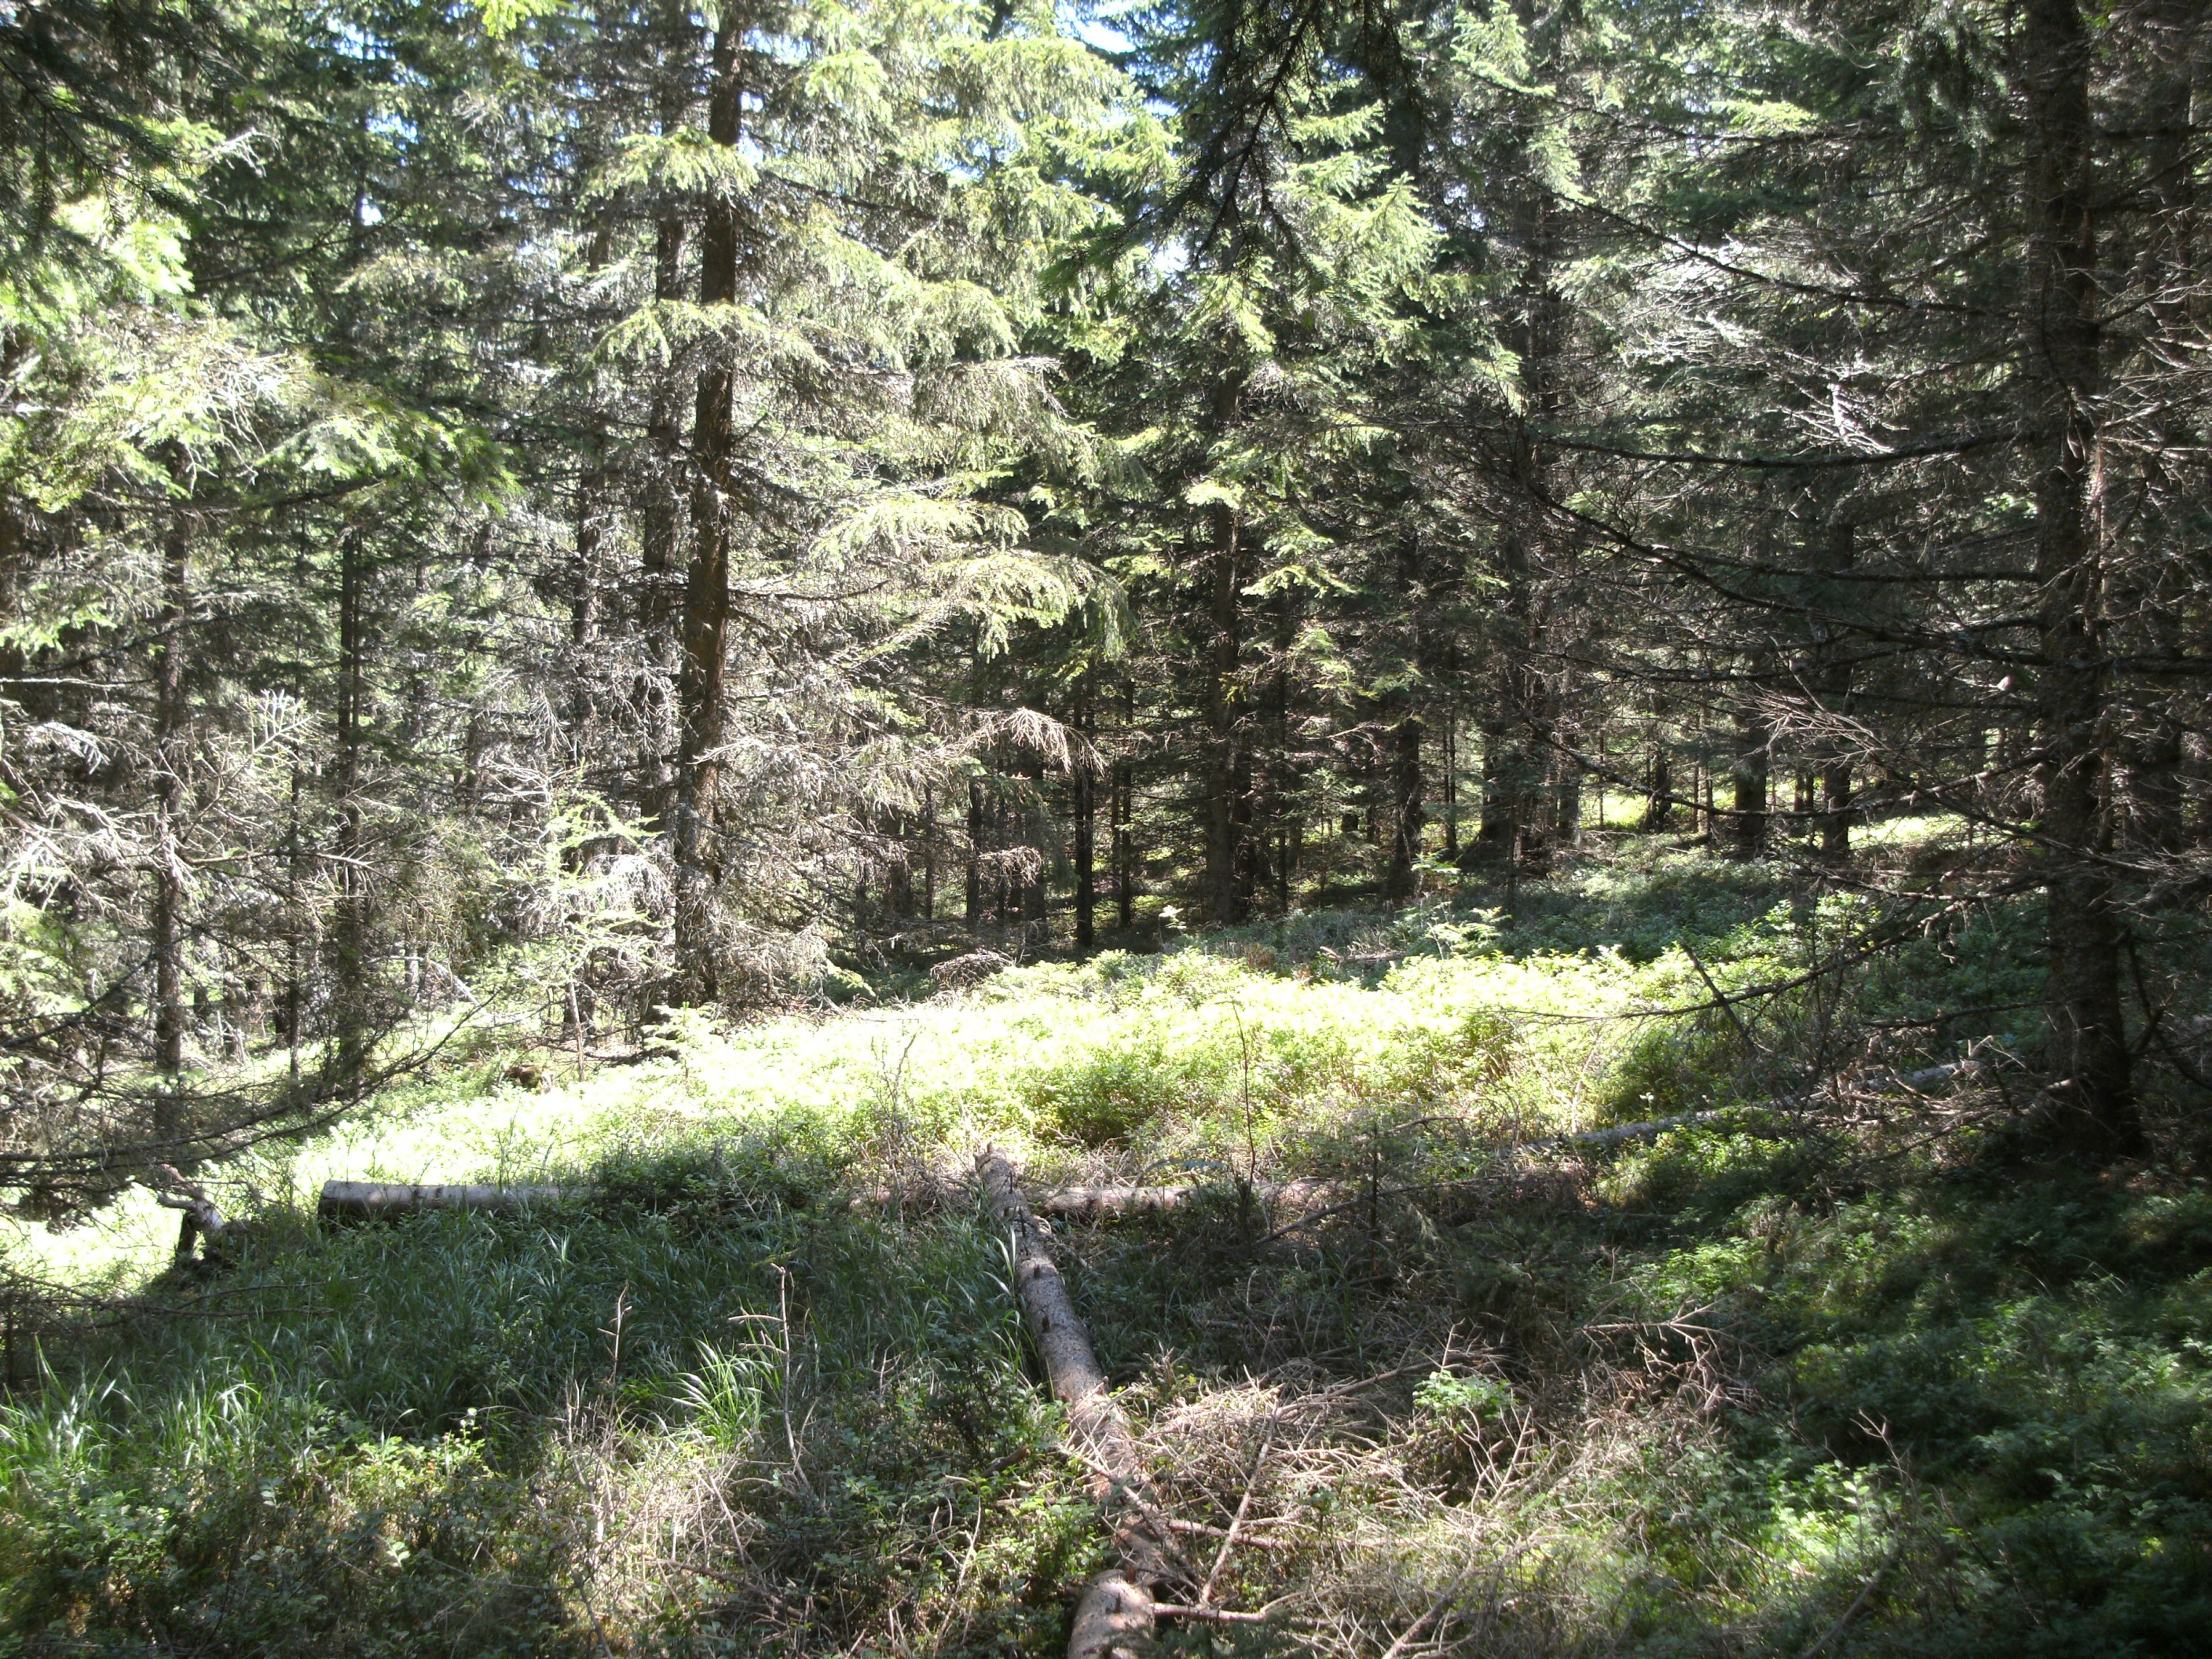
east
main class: Woodland
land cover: Spruce dominated coniferous woodland
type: alpine coniferous forest
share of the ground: 50 - 75 %
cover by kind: coniferous forest trees 75 %, shrubs 15 %, herbaceous plants 10 %
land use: Forestry
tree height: > 5 m
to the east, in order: Spruce dominated coniferous woodland; Tracks; Spruce dominated coniferous woodland; Fences; Spruce dominated coniferous woodland
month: July
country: AT
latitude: 46.9043
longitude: 14.9478
